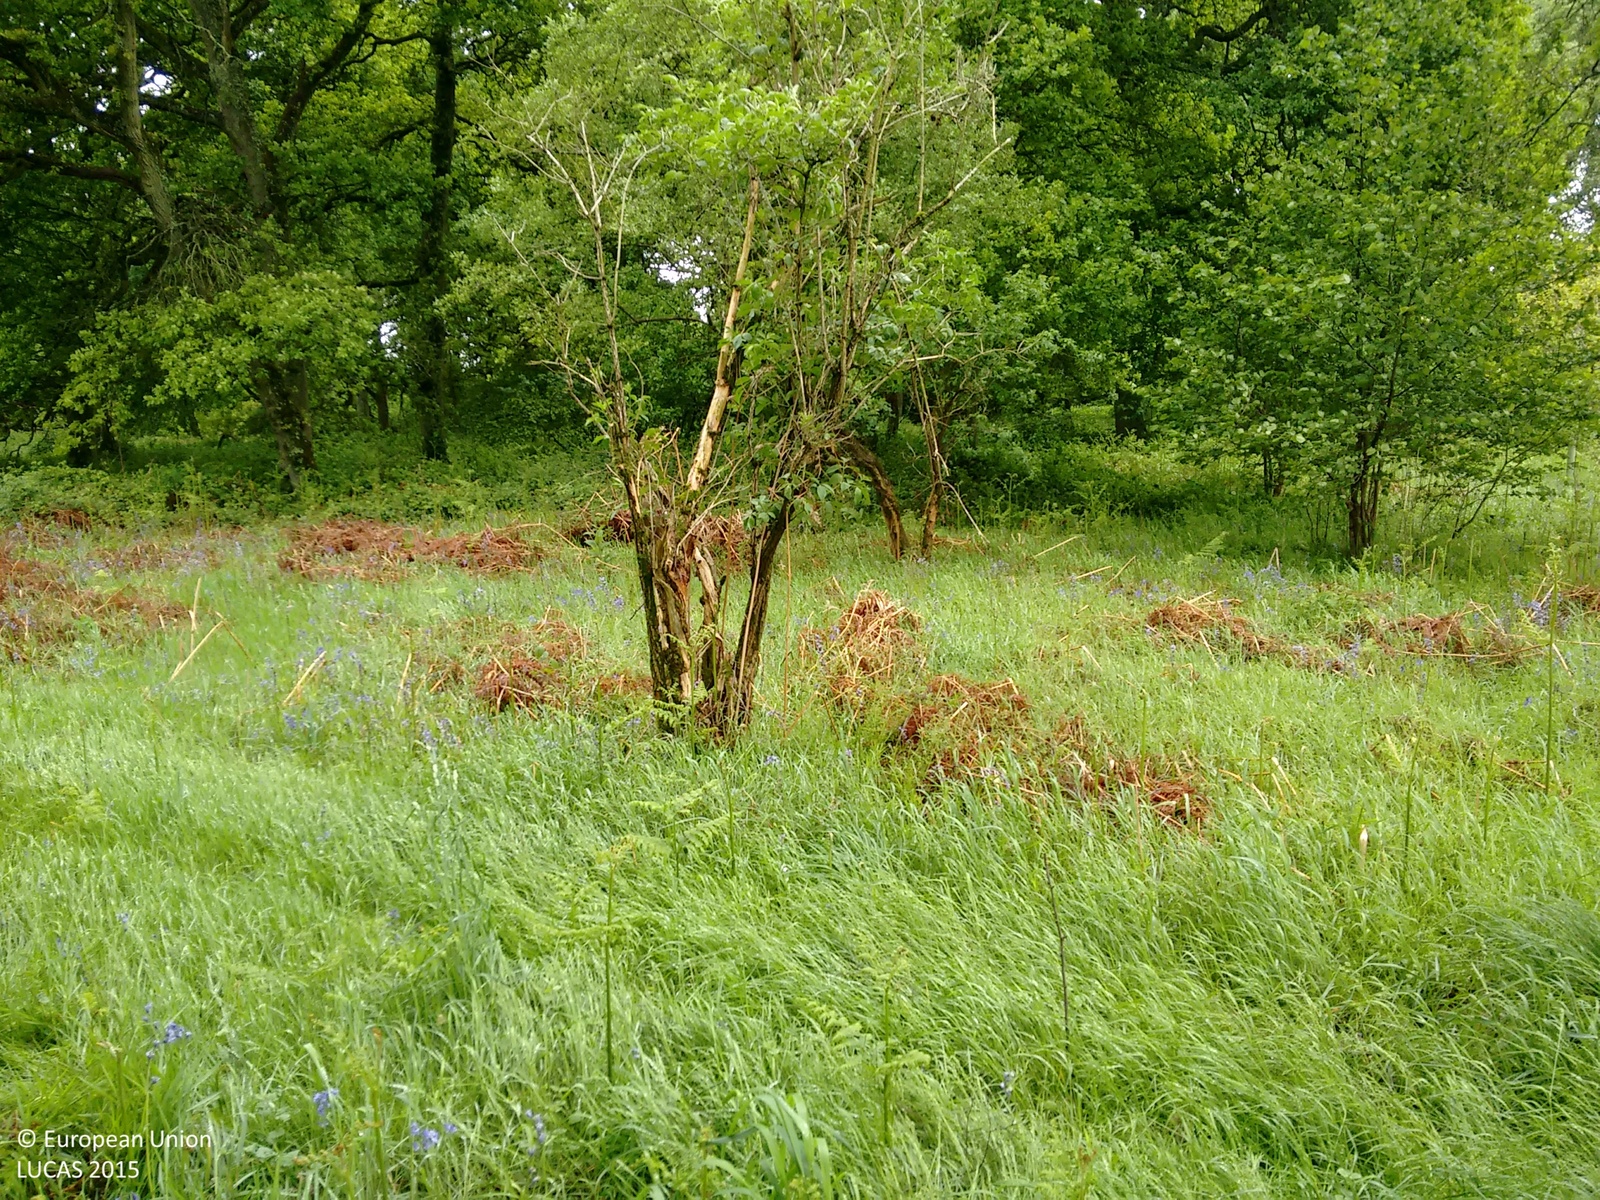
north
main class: Woodland
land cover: Broadleaved woodland
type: mesophytic deciduous forest
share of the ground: > 75 %
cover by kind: broadleaved forest trees 90 %, herbaceous plants 10 %
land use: Amenities, museums, leisure
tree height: > 5 m
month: June
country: GB
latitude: 51.1953
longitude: -1.1655
